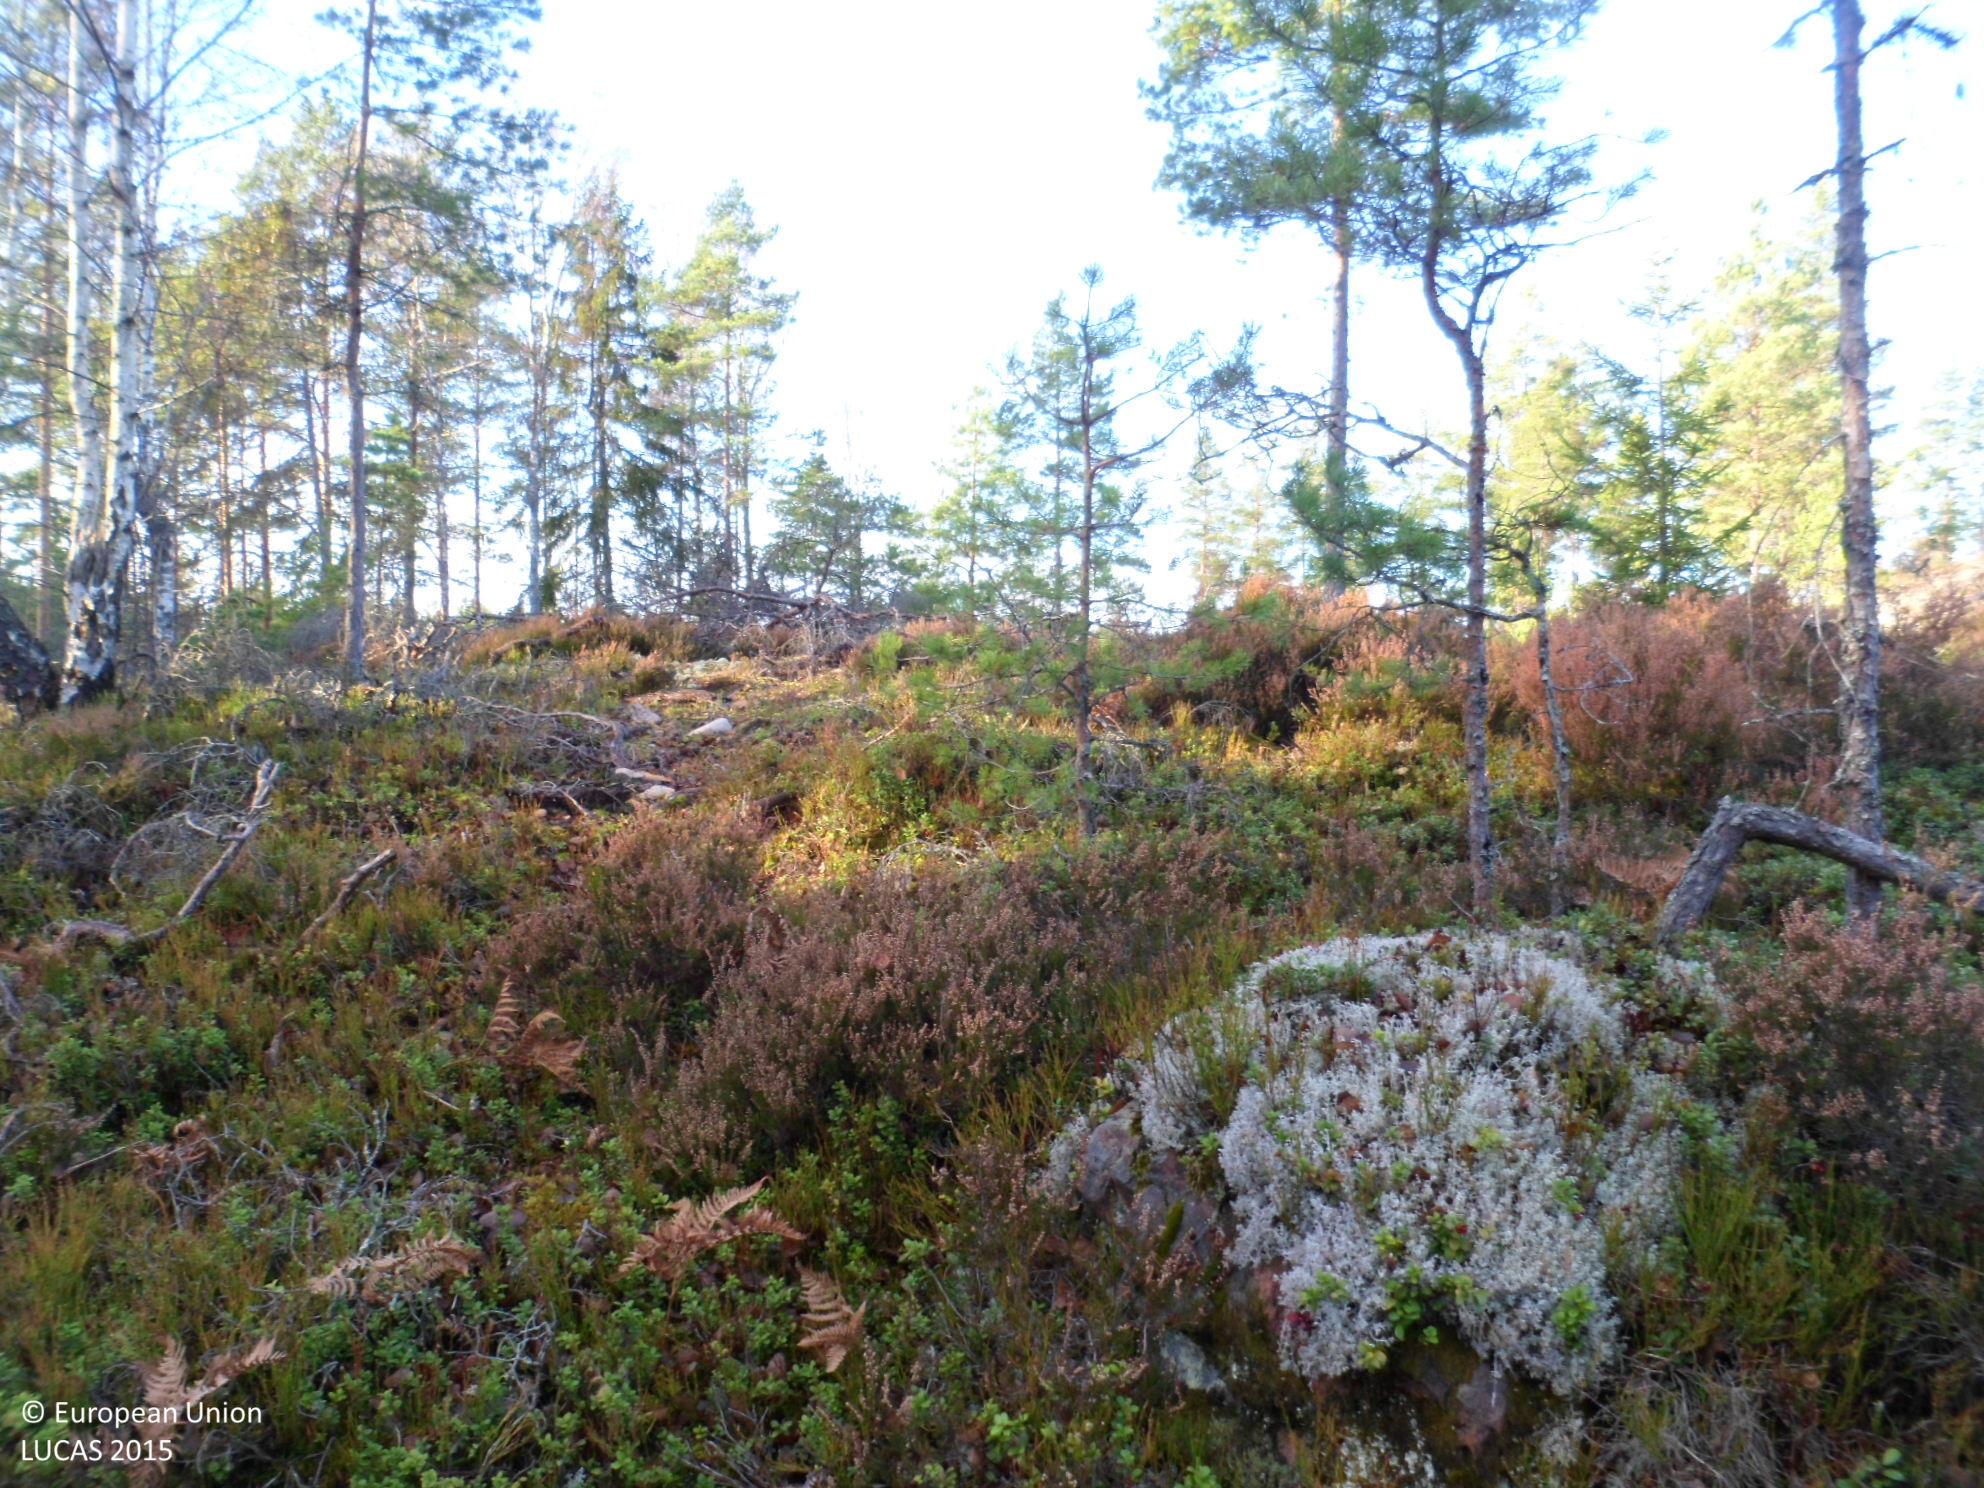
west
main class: Woodland
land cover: Pine dominated coniferous woodland
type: boreal forest
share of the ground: 25 - 50 %
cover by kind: coniferous forest trees 40 %, shrubs 35 %, broadleaved forest trees 10 %, lichens and mosses 10 %, herbaceous plants 5 %
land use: Forestry
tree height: > 5 m
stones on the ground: 25 - 50 %
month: November
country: SE
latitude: 57.2207
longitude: 15.9770
